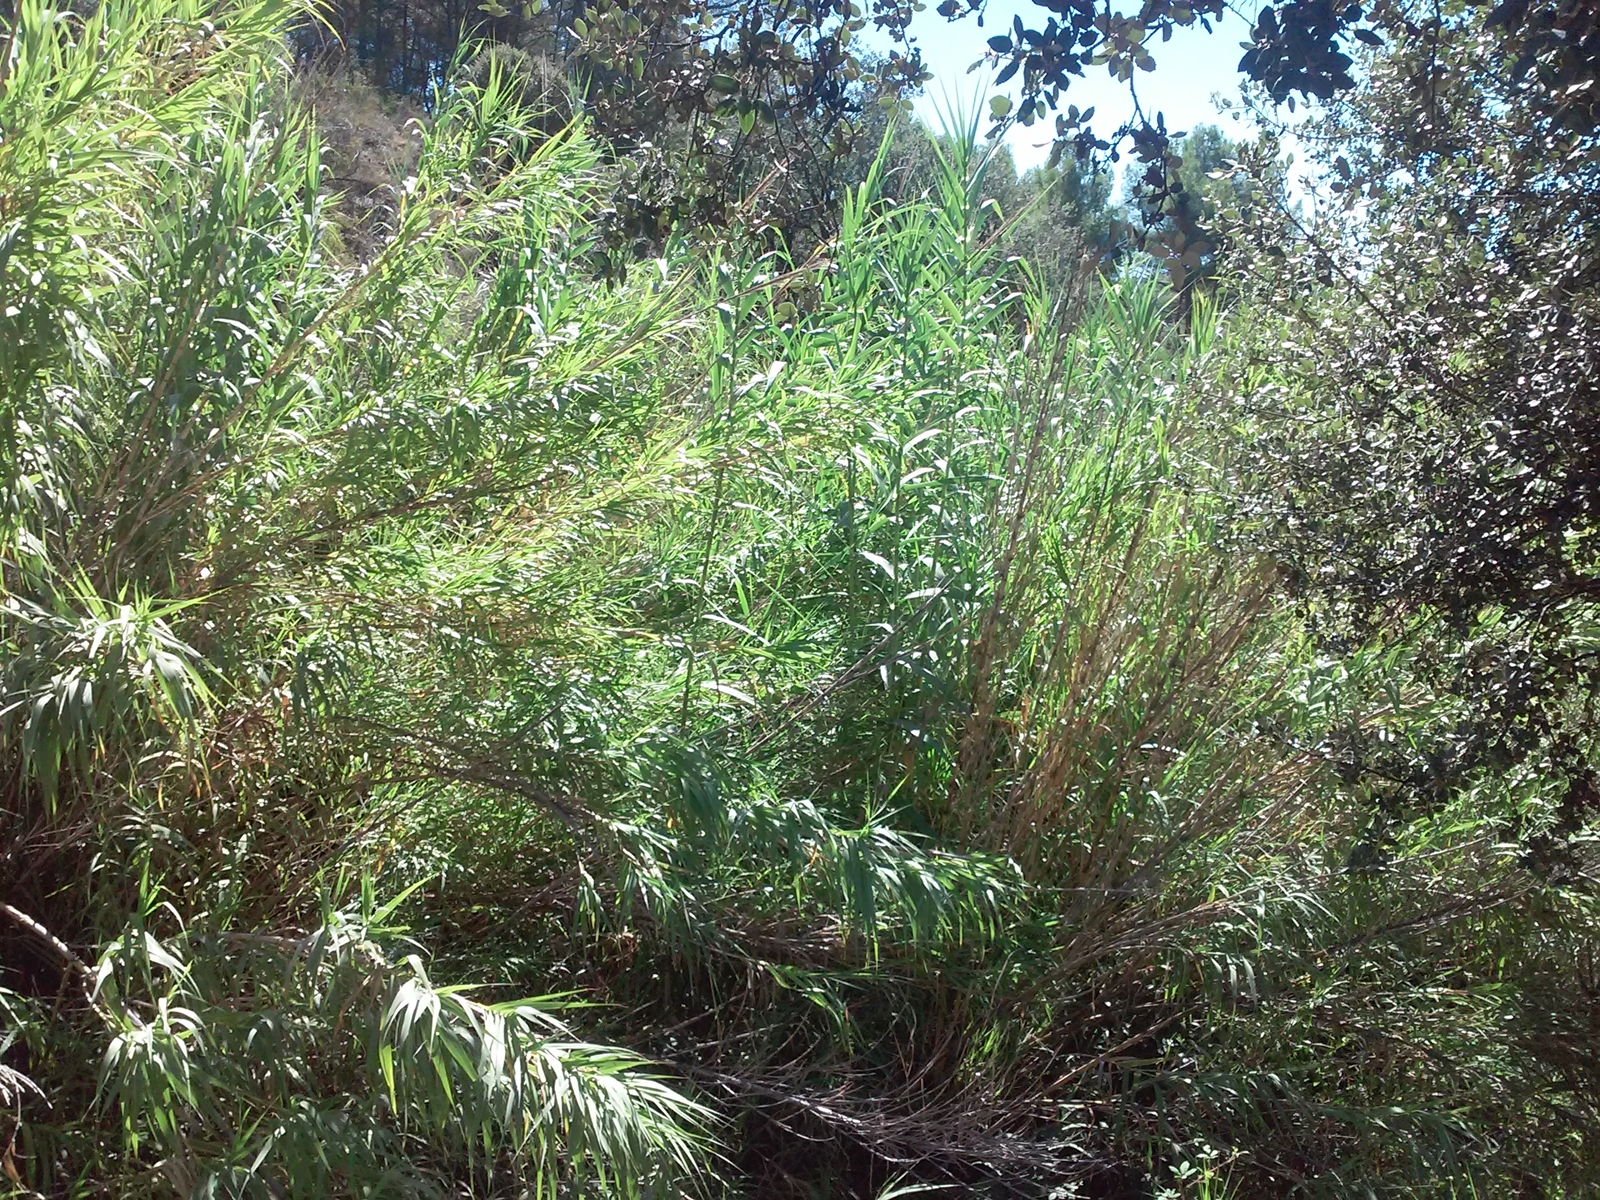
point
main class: Woodland
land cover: Pine dominated mixed woodland
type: coniferous forest of the mediterranean region
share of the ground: 50 - 75 %
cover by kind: shrubs 50 %, coniferous forest trees 25 %, broadleaved forest trees 25 %
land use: Semi-natural and natural areas not in use
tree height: < 5 m
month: September
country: ES
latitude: 41.2164
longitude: 0.7954
